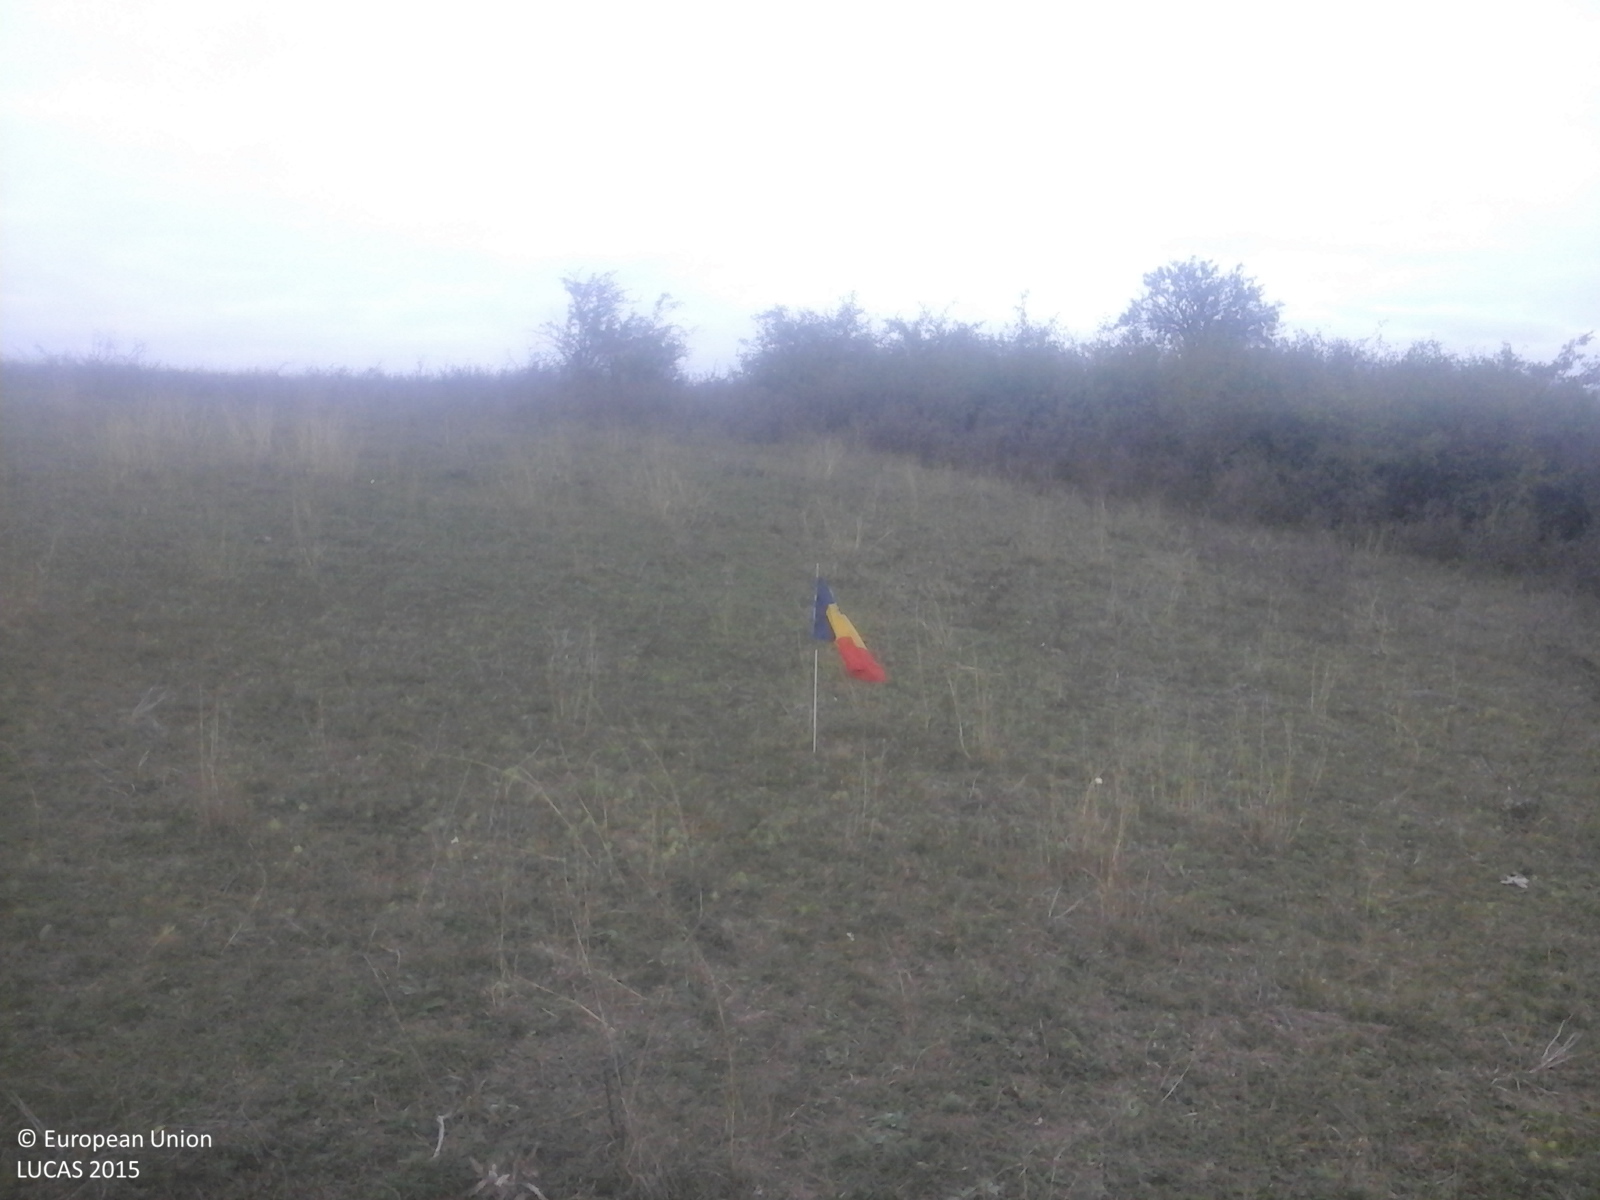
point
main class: Grassland
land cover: Grassland with sparse tree/shrub cover
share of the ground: > 75 %
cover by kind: herbaceous plants 85 %, shrubs 10 %, broadleaved forest trees 5 %
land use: Fallow land
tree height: < 5 m
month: September
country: RO
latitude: 45.9083
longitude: 23.7982
